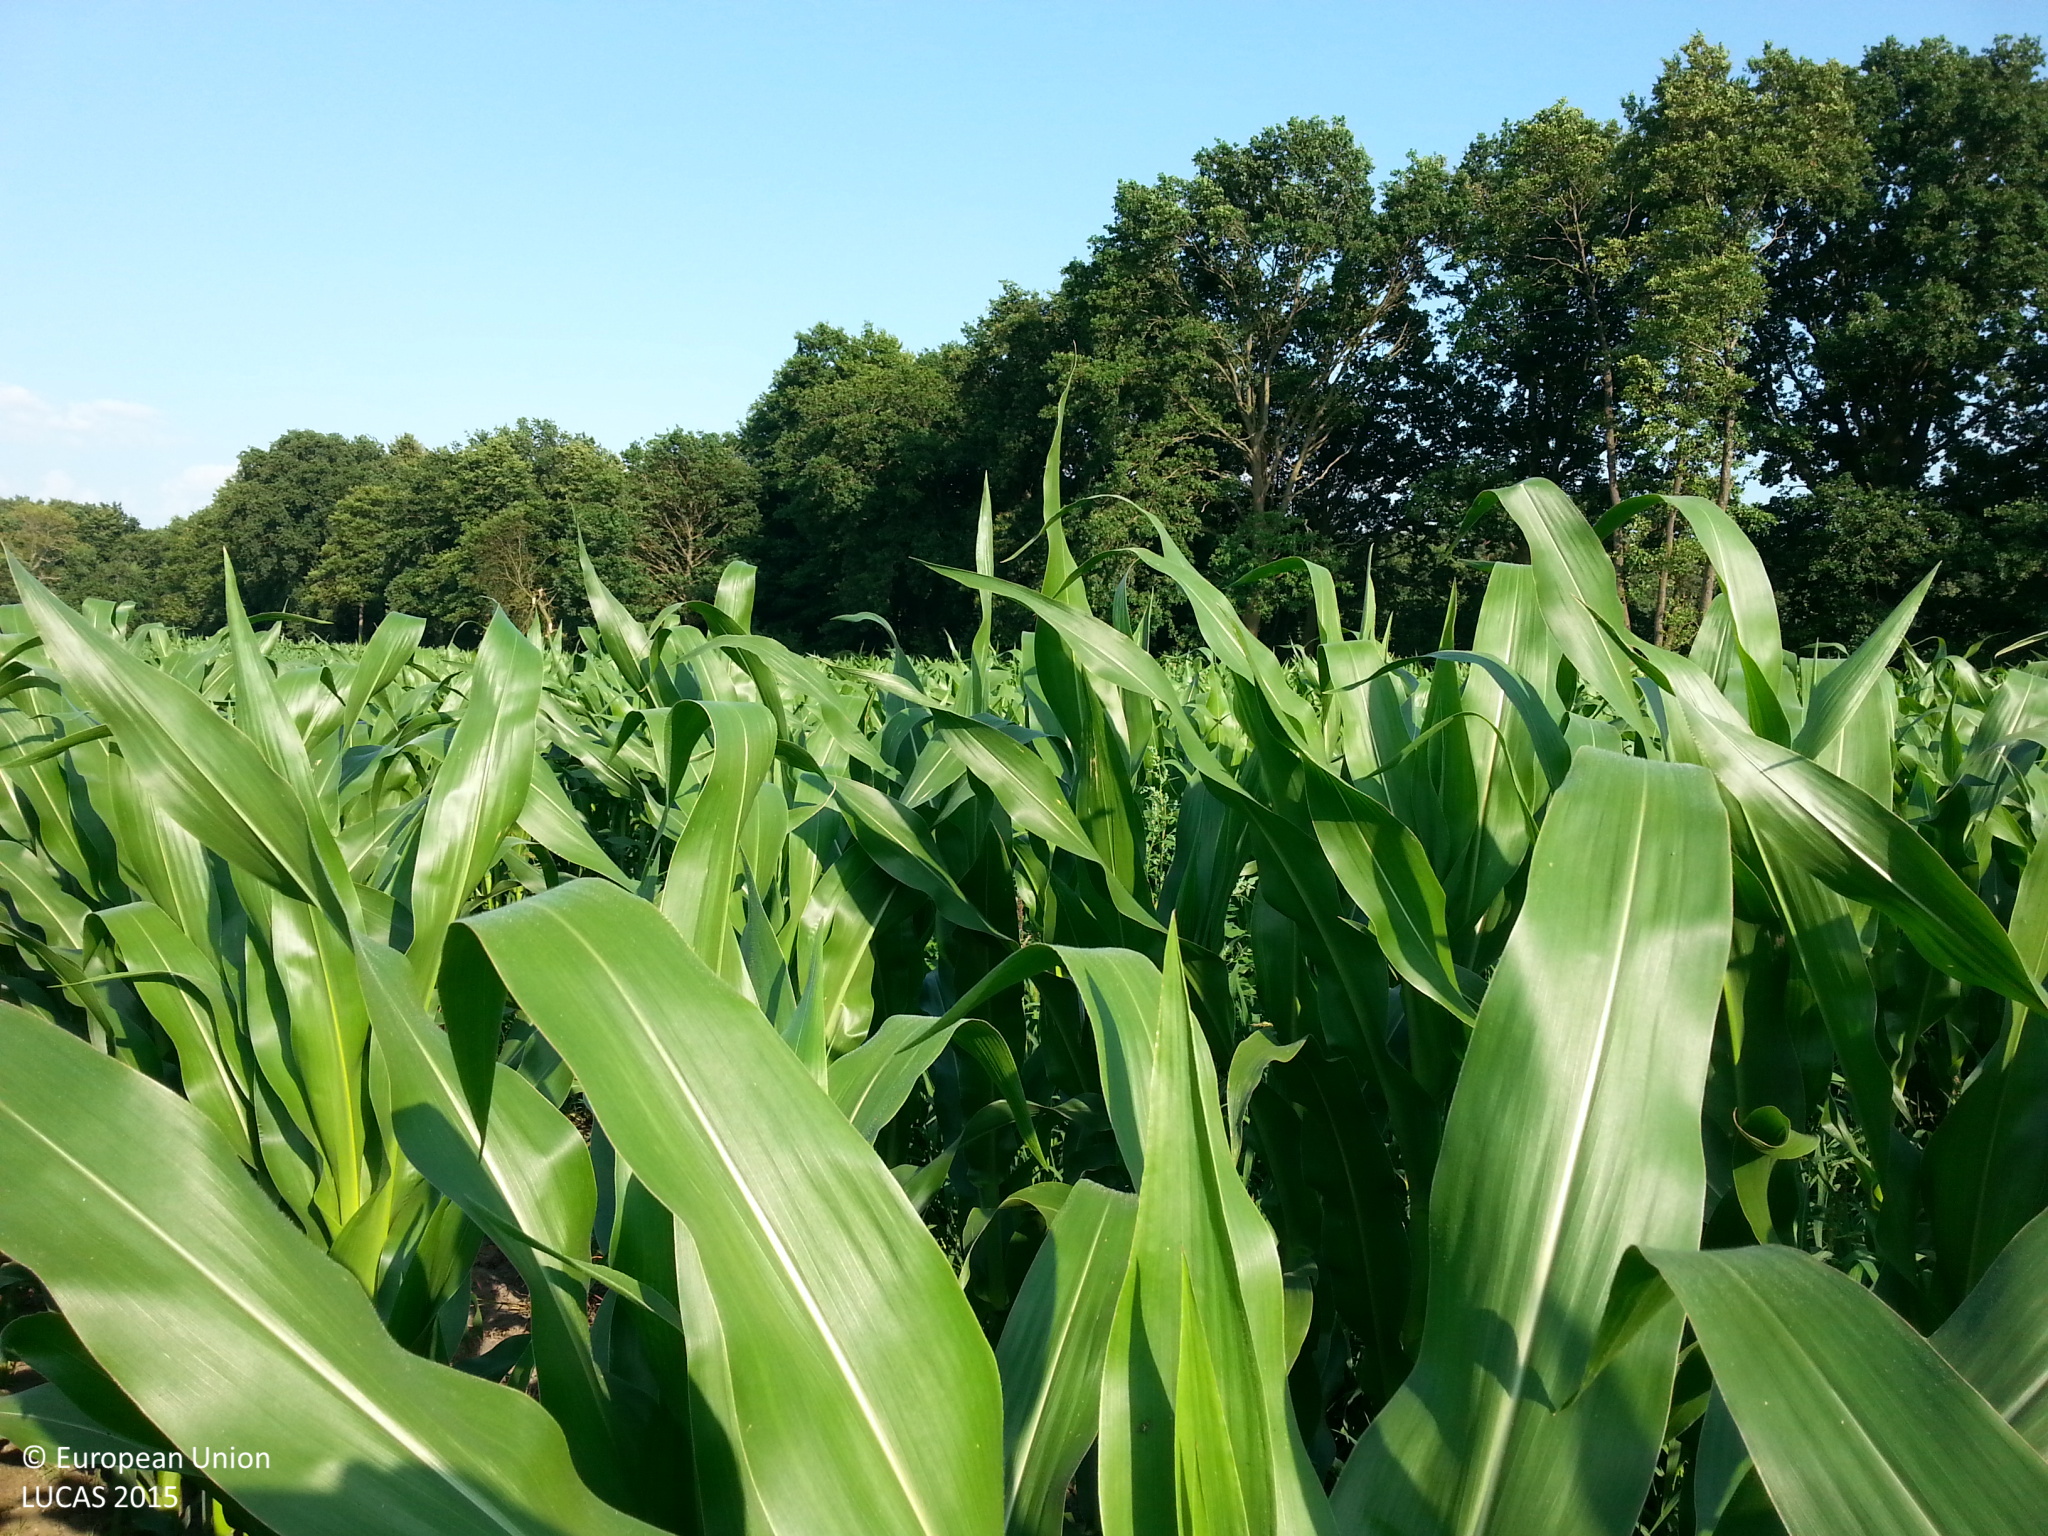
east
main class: Cropland
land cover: Maize
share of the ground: > 75 %
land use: Agriculture (excluding fallow land and kitchen gardens)
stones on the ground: < 10 %
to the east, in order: Maize; Grass margins; Ditches and canals; Grass margins; Maize
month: July
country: DE
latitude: 53.3436
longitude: 11.0359
